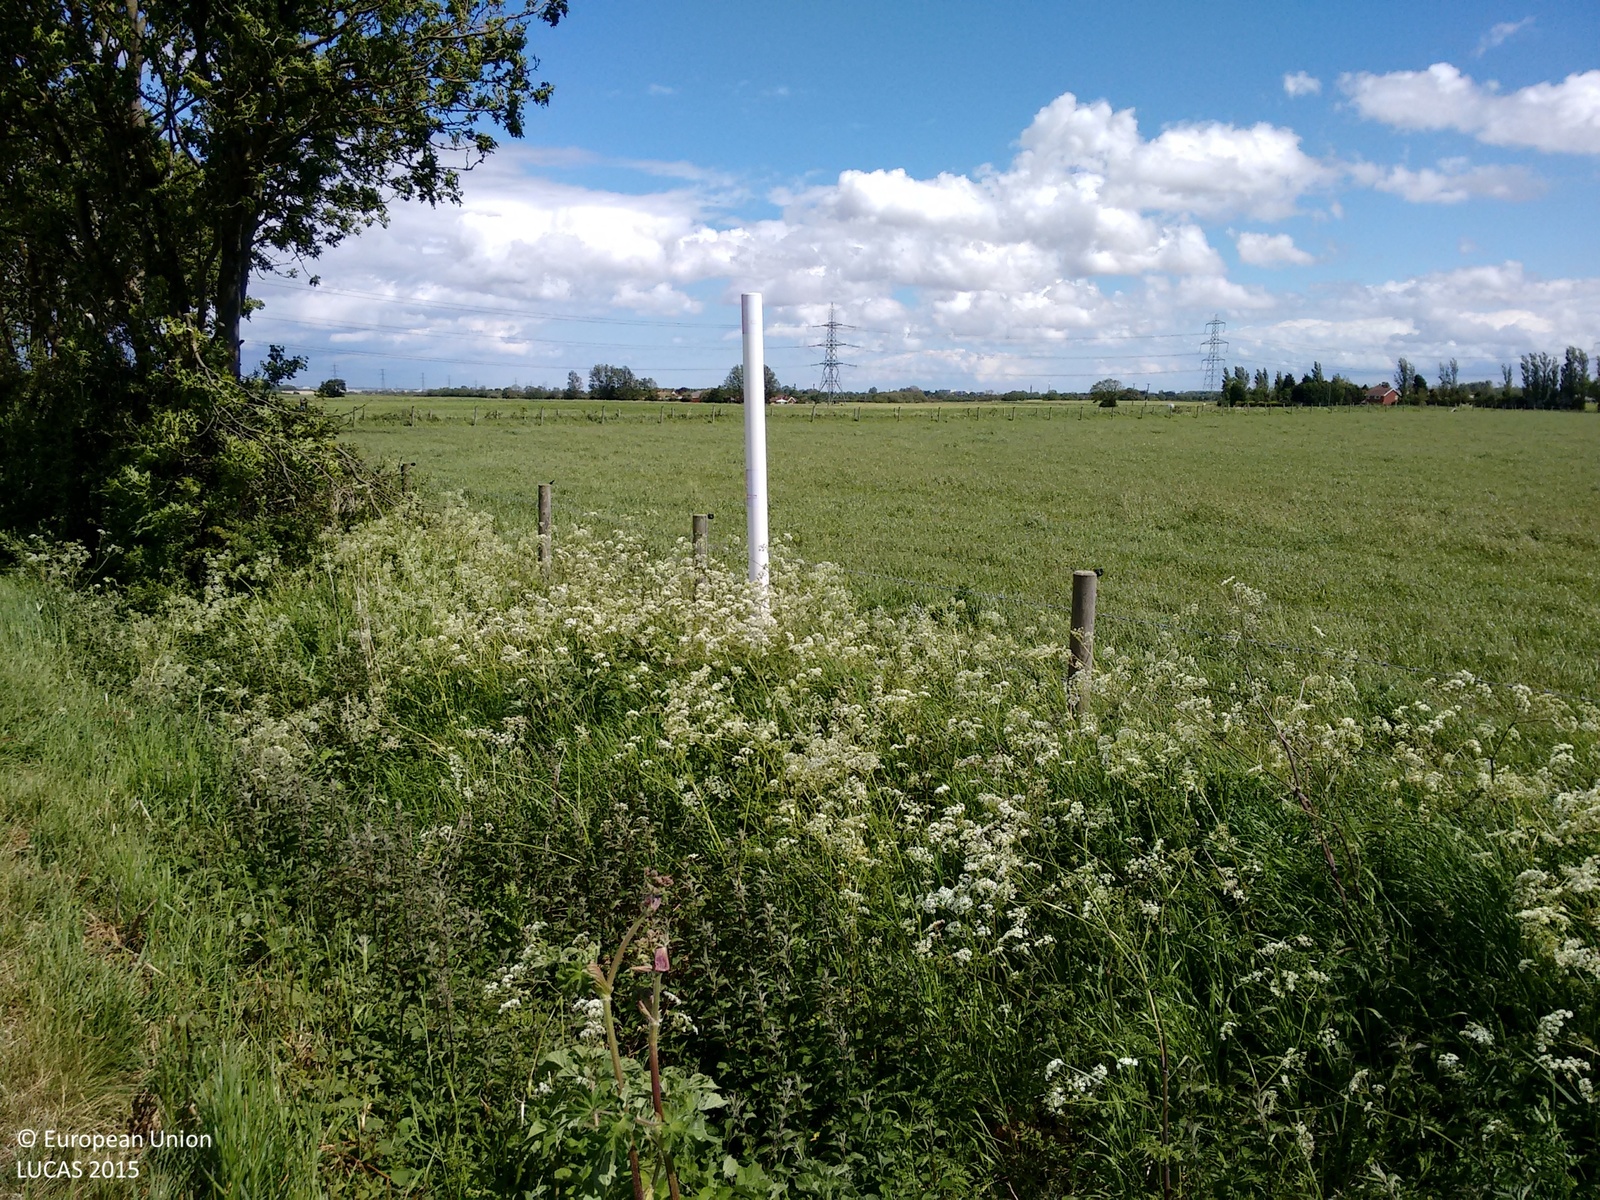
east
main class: Grassland
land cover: Grassland without tree/shrub cover
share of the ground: > 75 %
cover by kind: herbaceous plants 100 %
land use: Agriculture (excluding fallow land and kitchen gardens)
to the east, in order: Grassland without tree/shrub cover; Electric lines; Grassland without tree/shrub cover
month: June
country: GB
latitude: 53.5839
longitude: -0.2302
